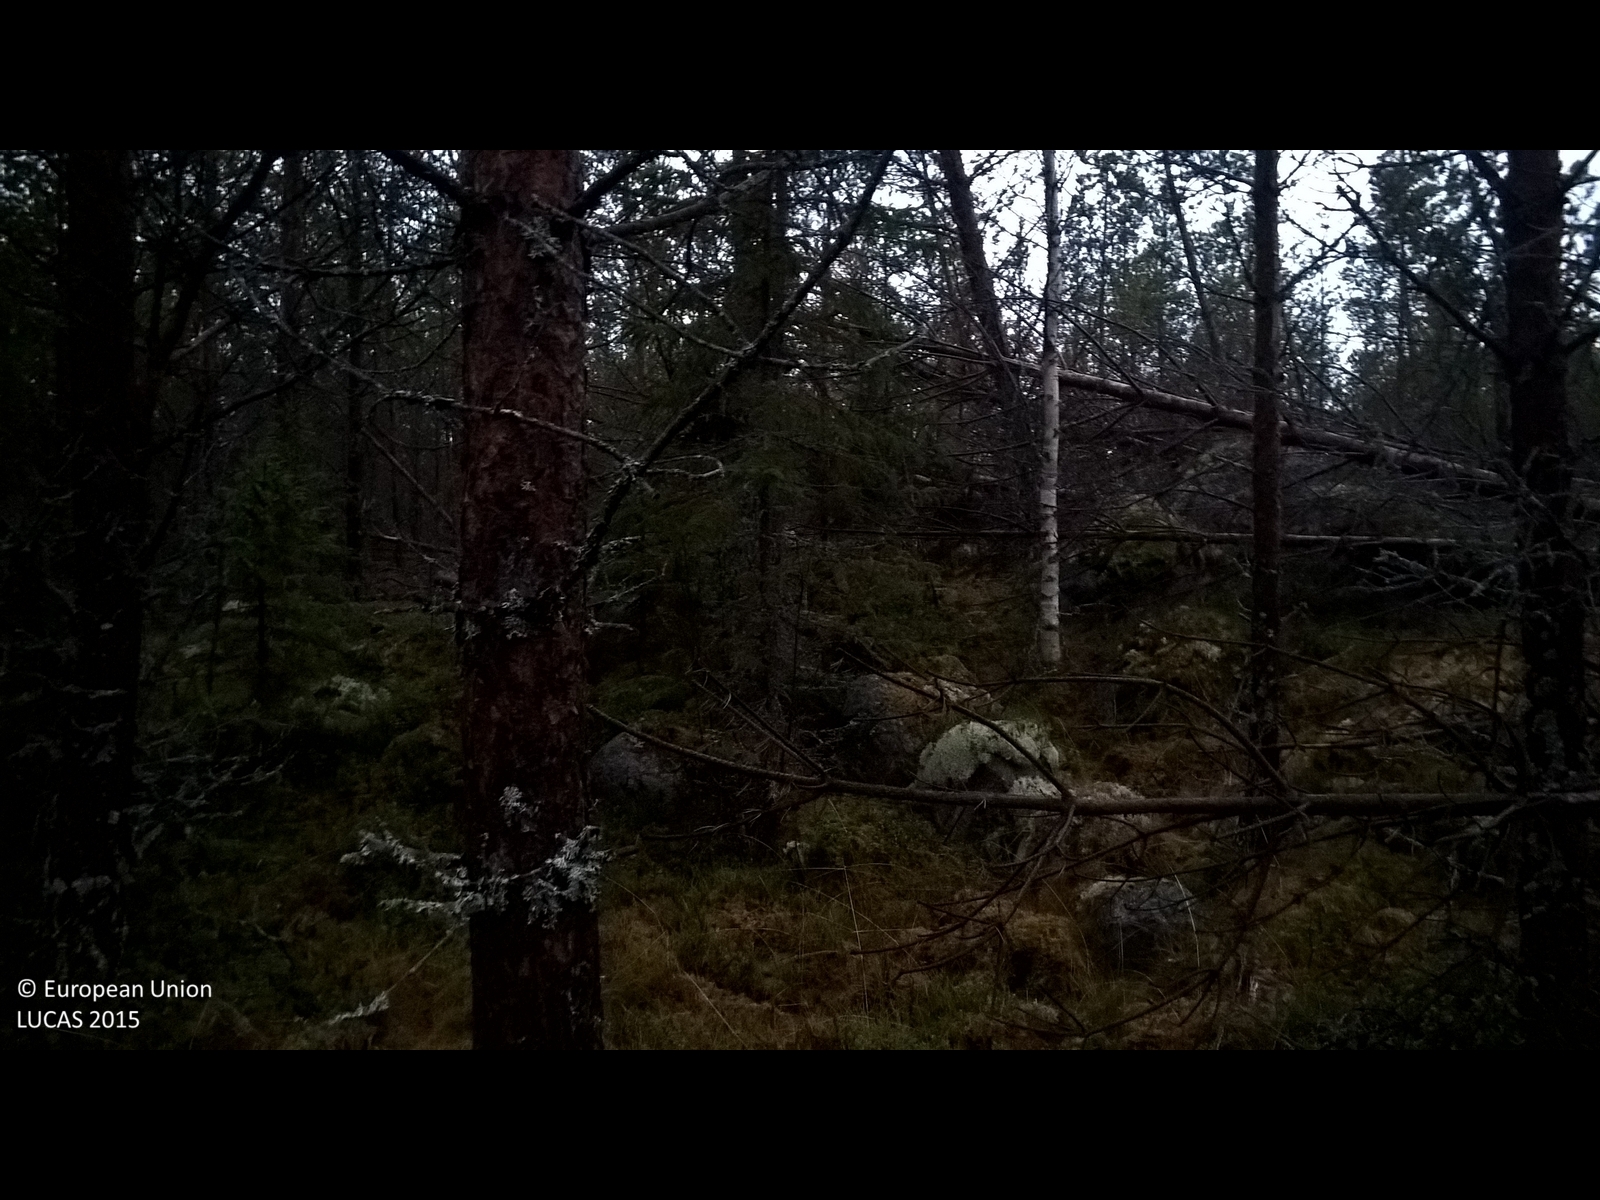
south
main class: Woodland
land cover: Pine dominated coniferous woodland
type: boreal forest
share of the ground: > 75 %
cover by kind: coniferous forest trees 70 %, broadleaved forest trees 10 %, shrubs 10 %, lichens and mosses 10 %
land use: Forestry
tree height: > 5 m
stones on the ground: < 10 %
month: November
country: SE
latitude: 61.9668
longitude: 15.0750
